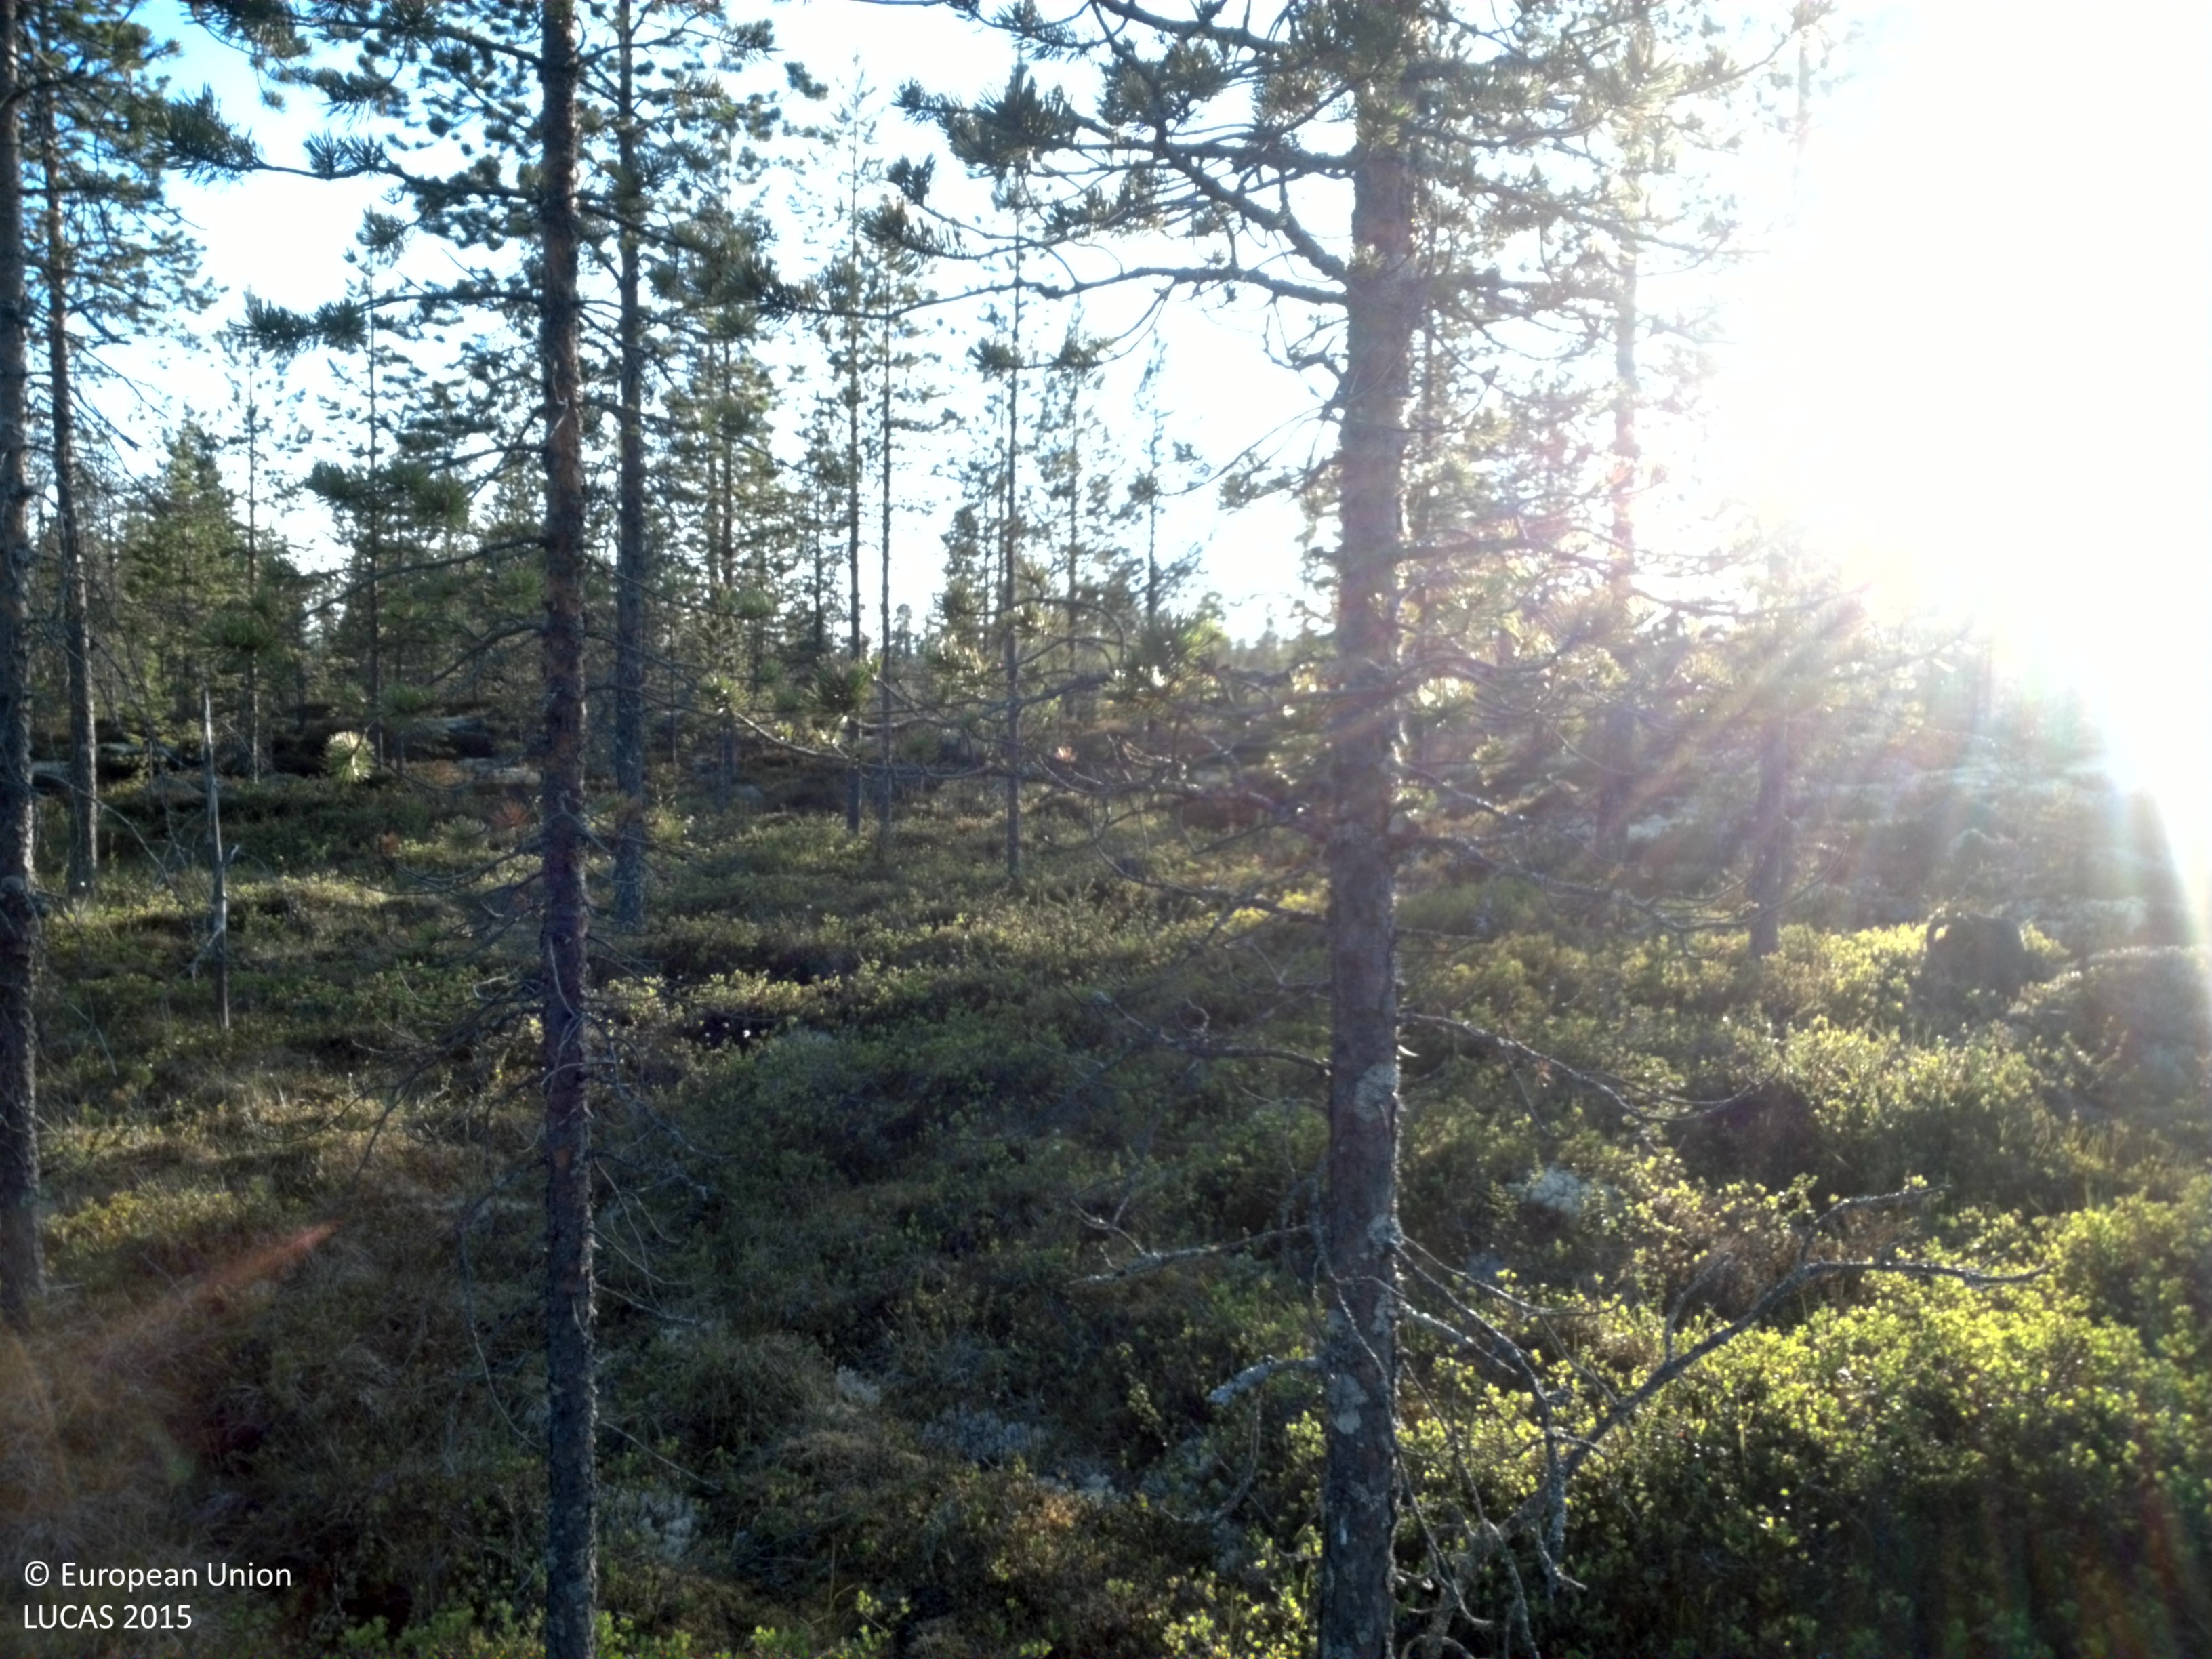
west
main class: Woodland
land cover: Pine dominated coniferous woodland
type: boreal forest
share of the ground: 10 - 25 %
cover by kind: shrubs 60 %, coniferous forest trees 25 %, lichens and mosses 15 %
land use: Forestry
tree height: > 5 m
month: June
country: SE
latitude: 61.8152
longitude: 12.5517
